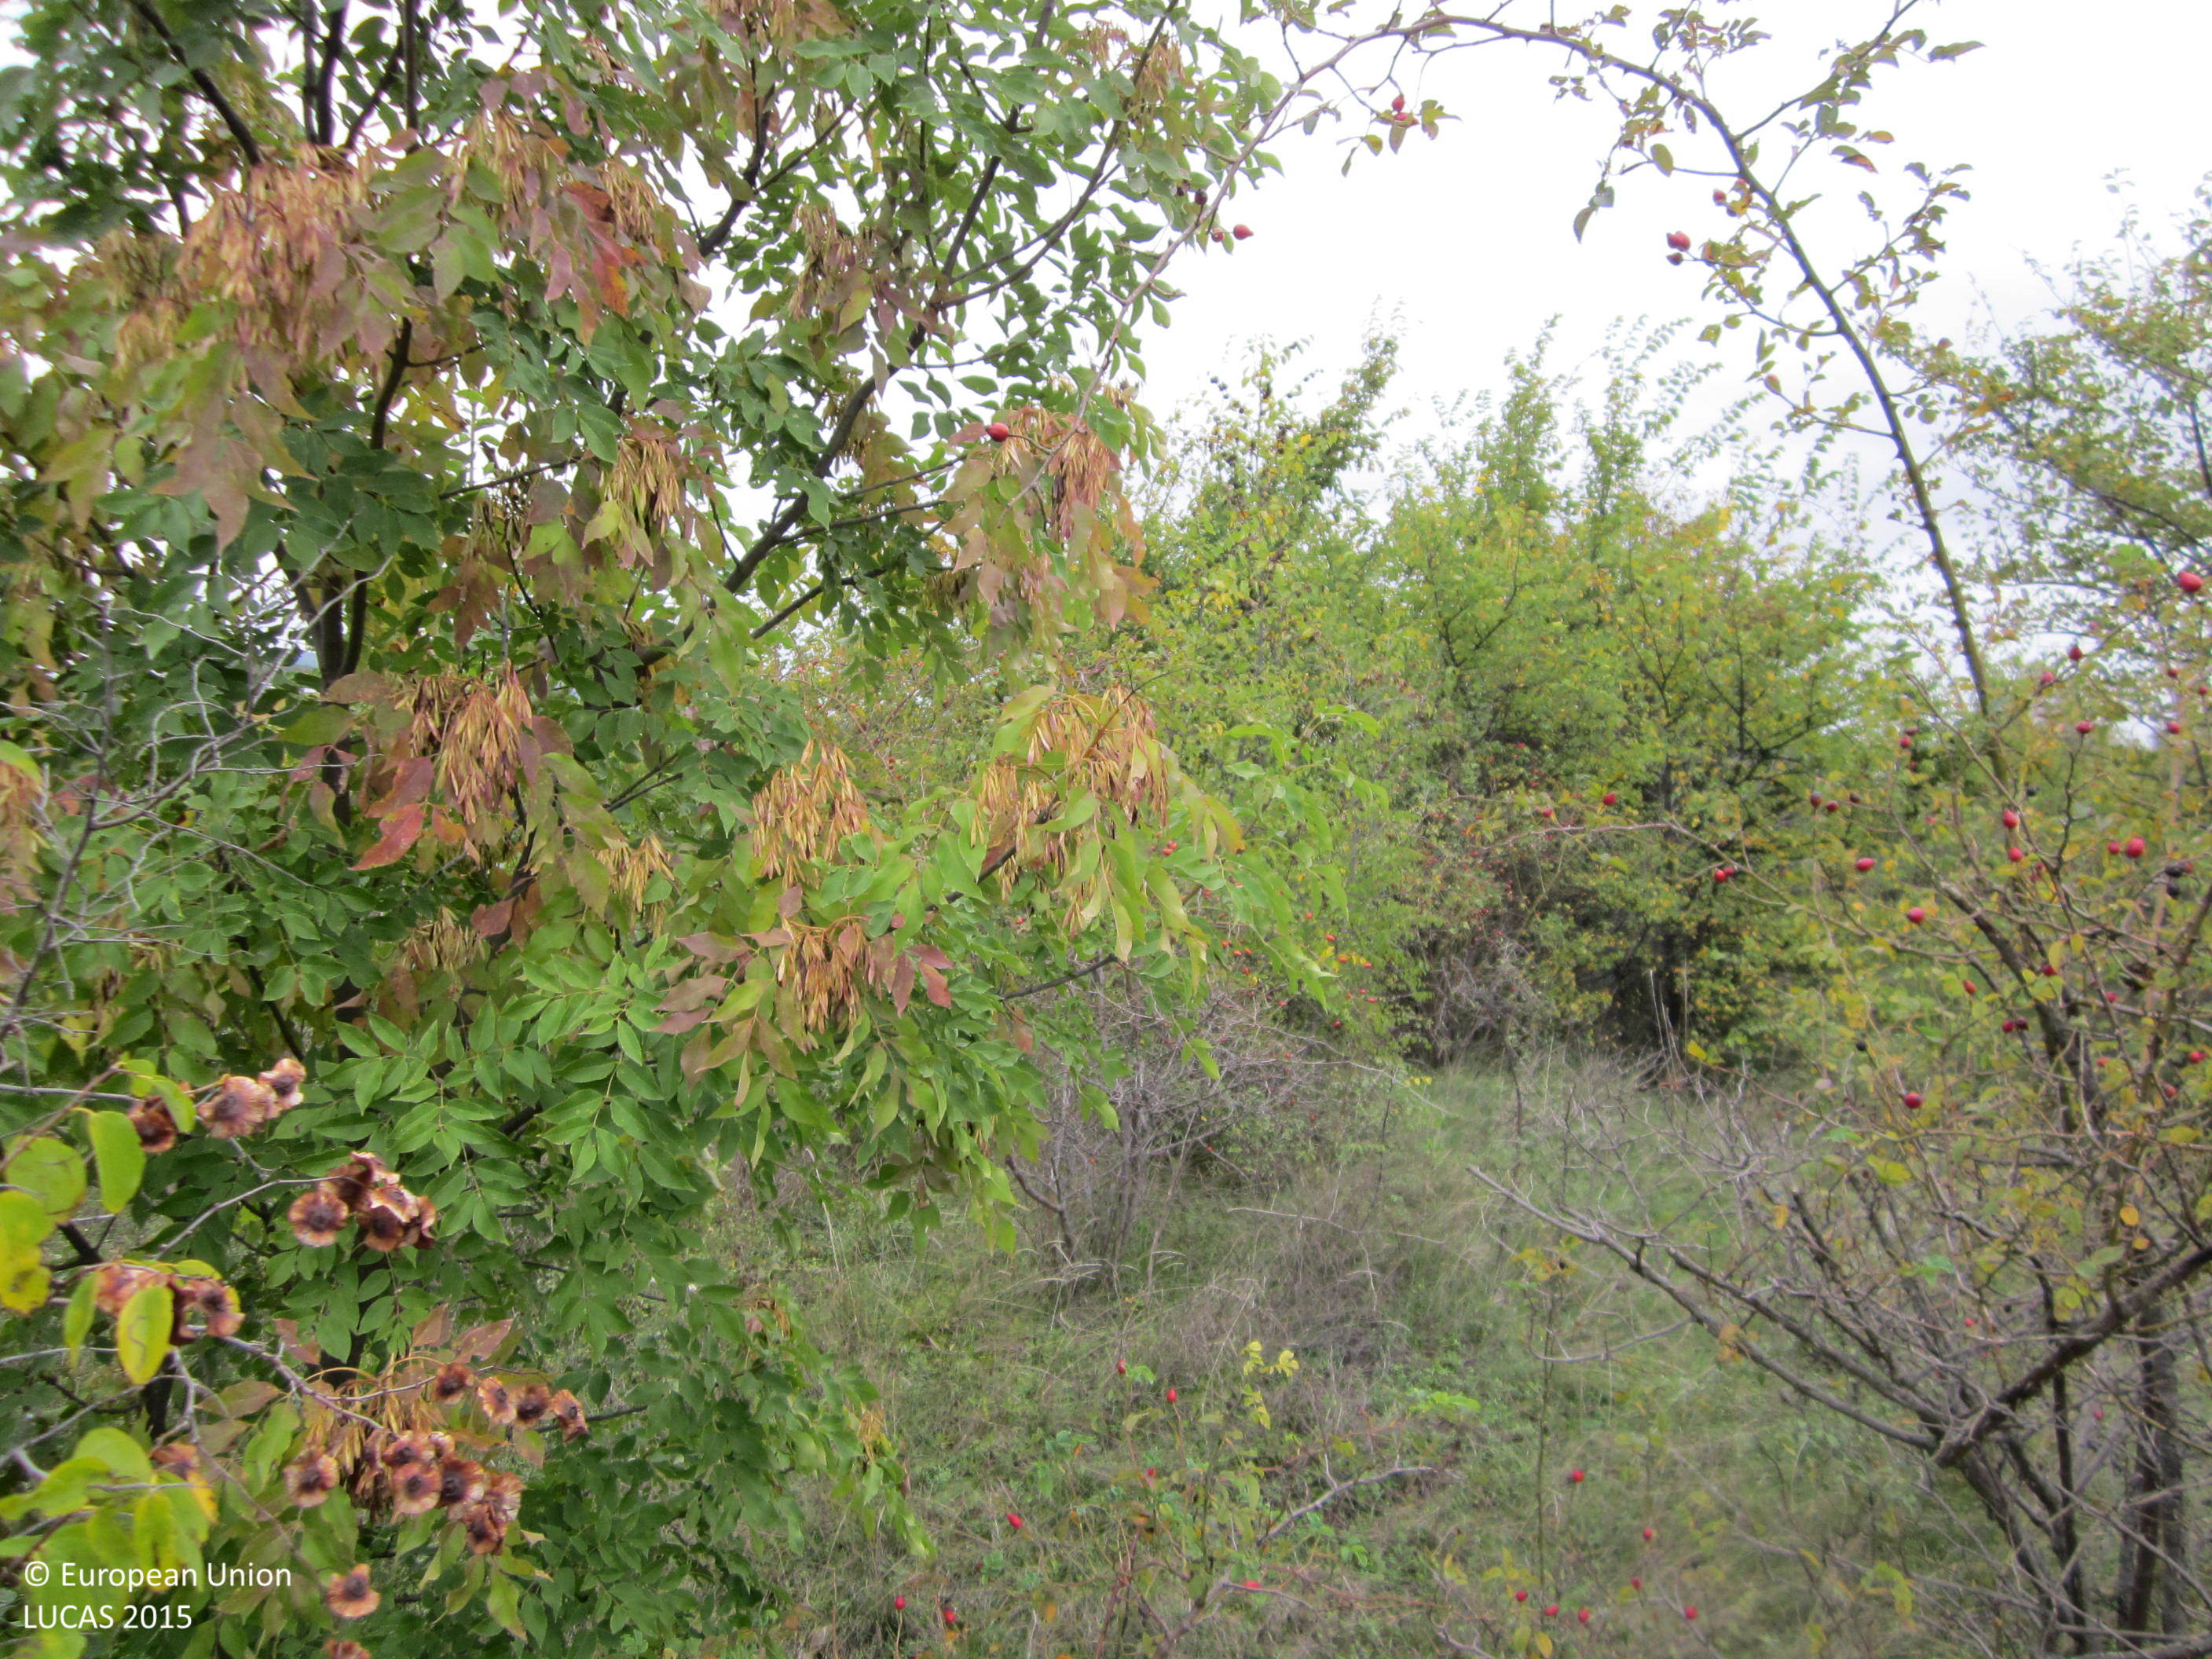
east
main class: Shrubland
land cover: Shrubland with sparse tree cover
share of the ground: > 75 %
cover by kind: shrubs 90 %, broadleaved forest trees 5 %, herbaceous plants 5 %
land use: Semi-natural and natural areas not in use
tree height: > 5 m
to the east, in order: Shrubland with sparse tree cover; Electric lines; Tracks; Shrubland with sparse tree cover; Shruby margins; Sunflower; Electric lines; Sunflower
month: October
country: BG
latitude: 42.7422
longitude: 27.0525
